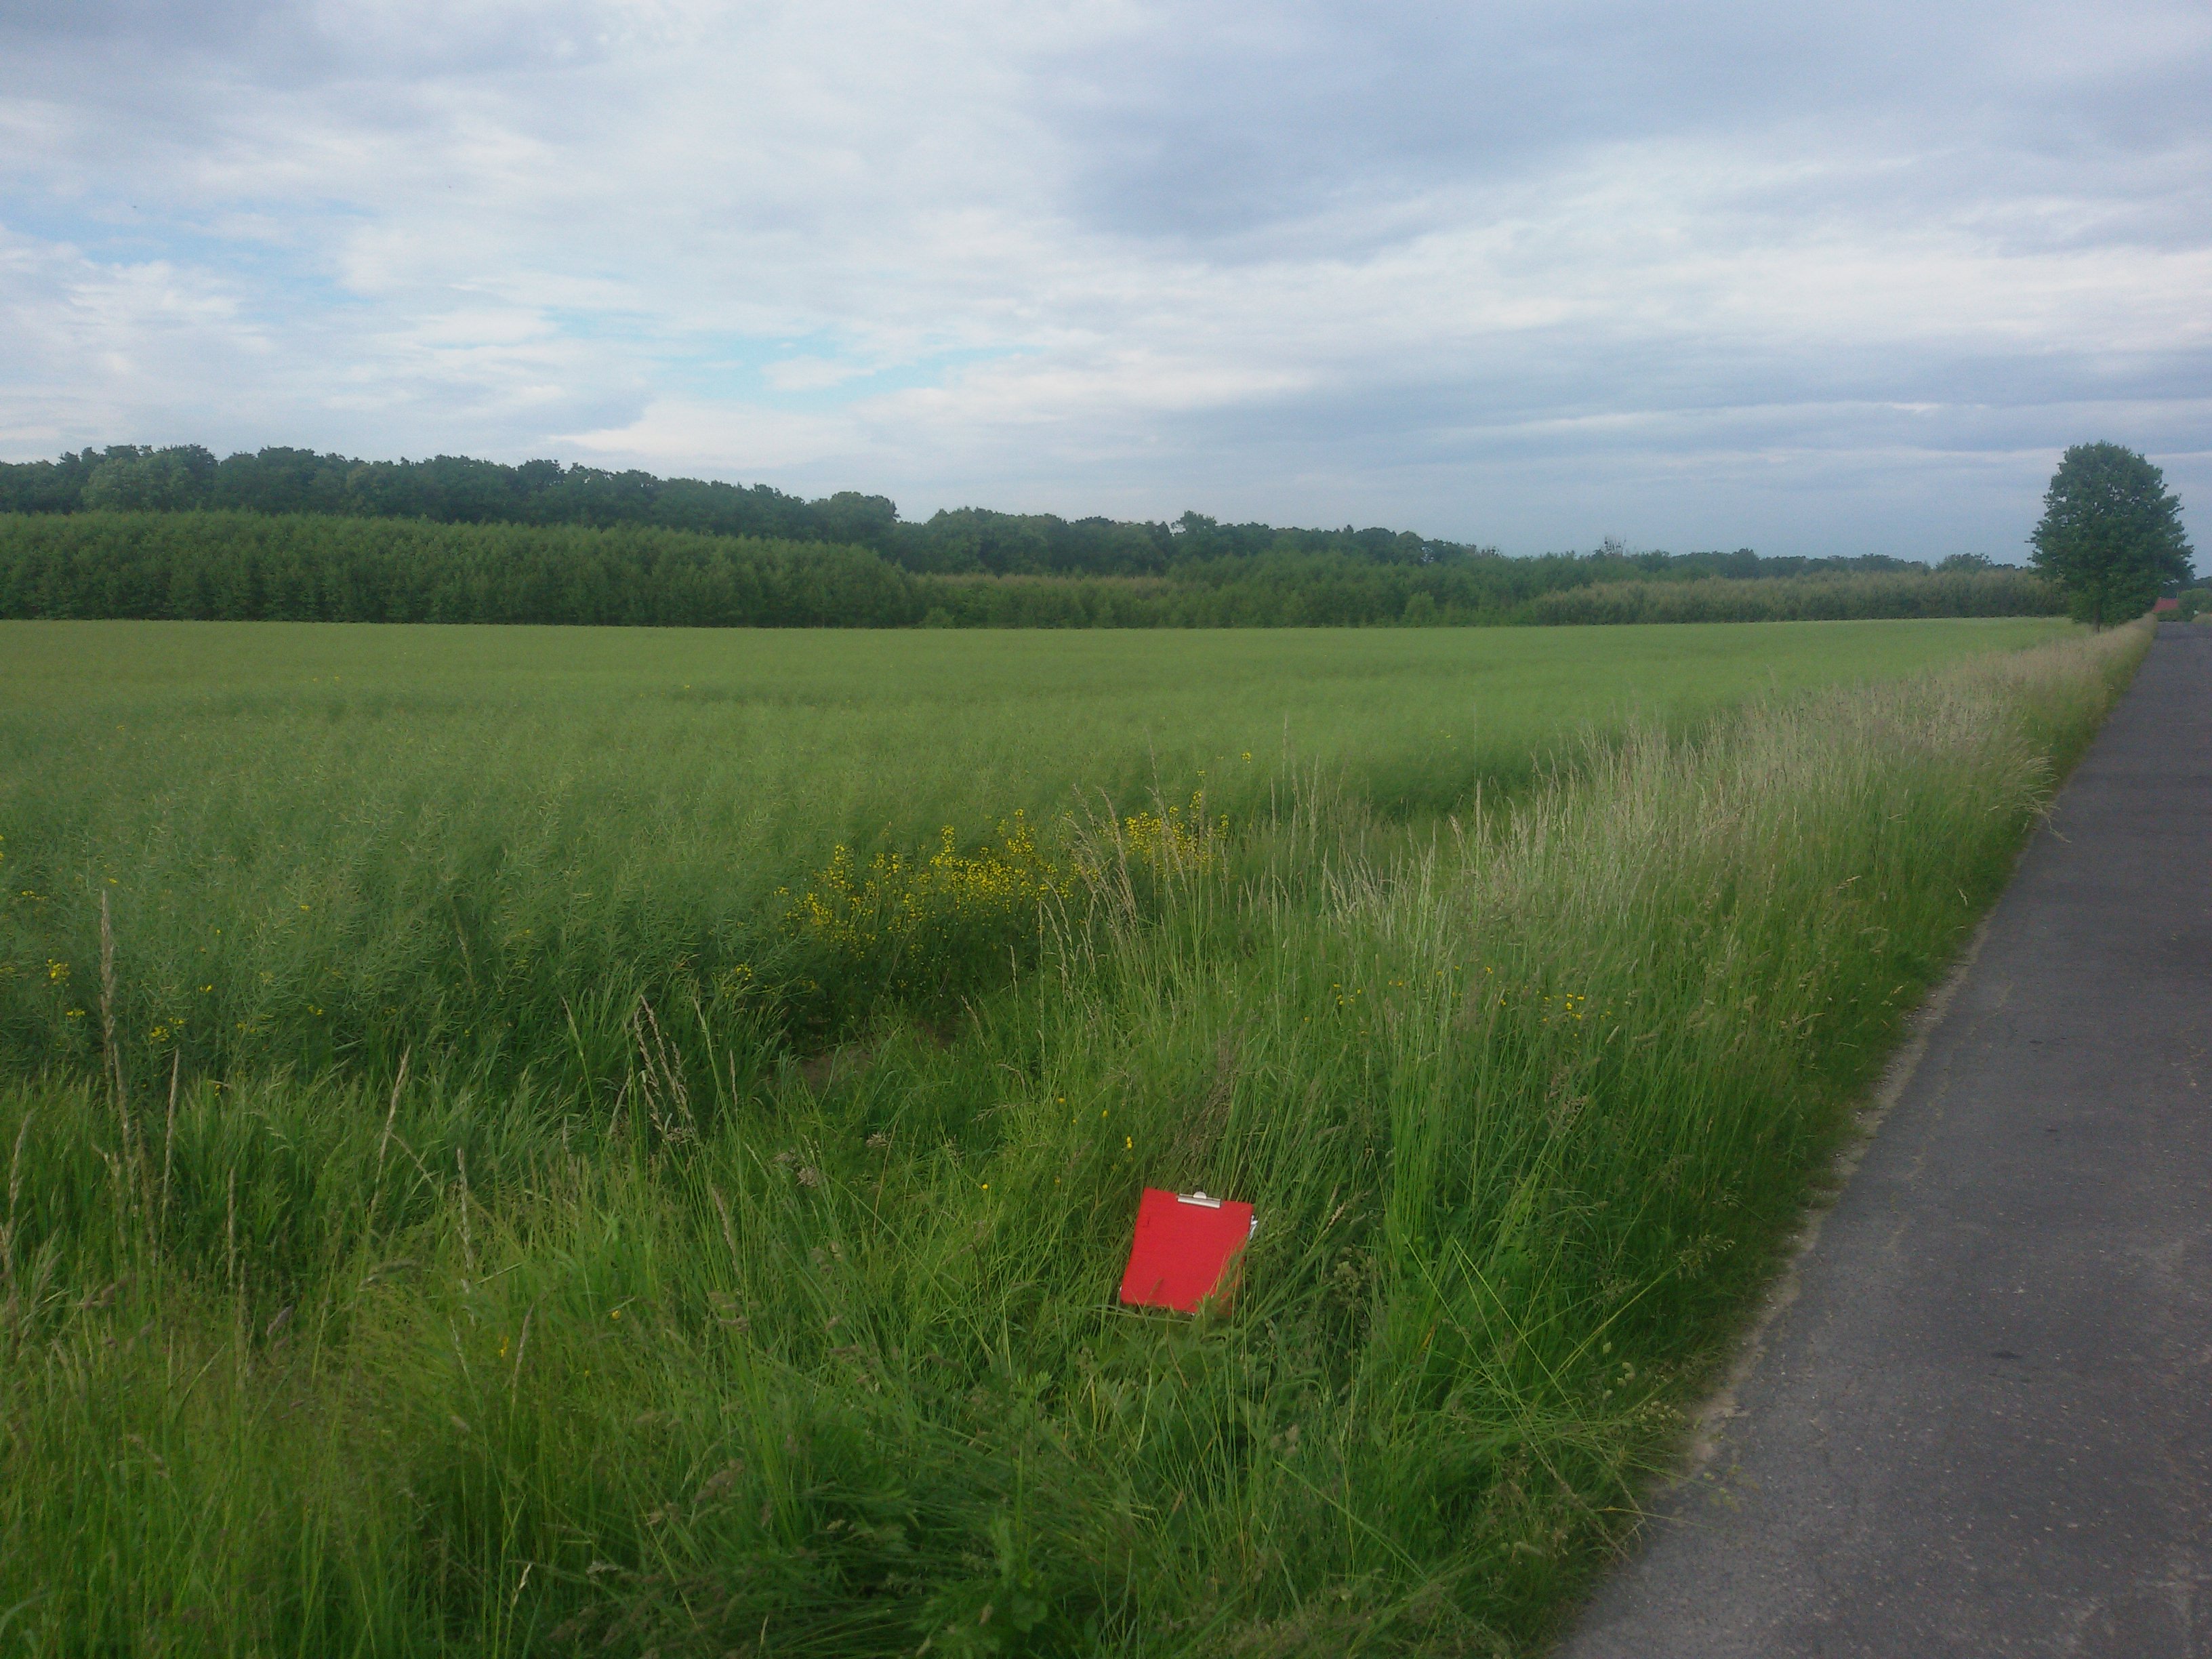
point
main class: Cropland
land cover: Rape and turnip rape
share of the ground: > 75 %
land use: Agriculture (excluding fallow land and kitchen gardens)
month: June
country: PL
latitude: 50.5056
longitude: 17.6416
